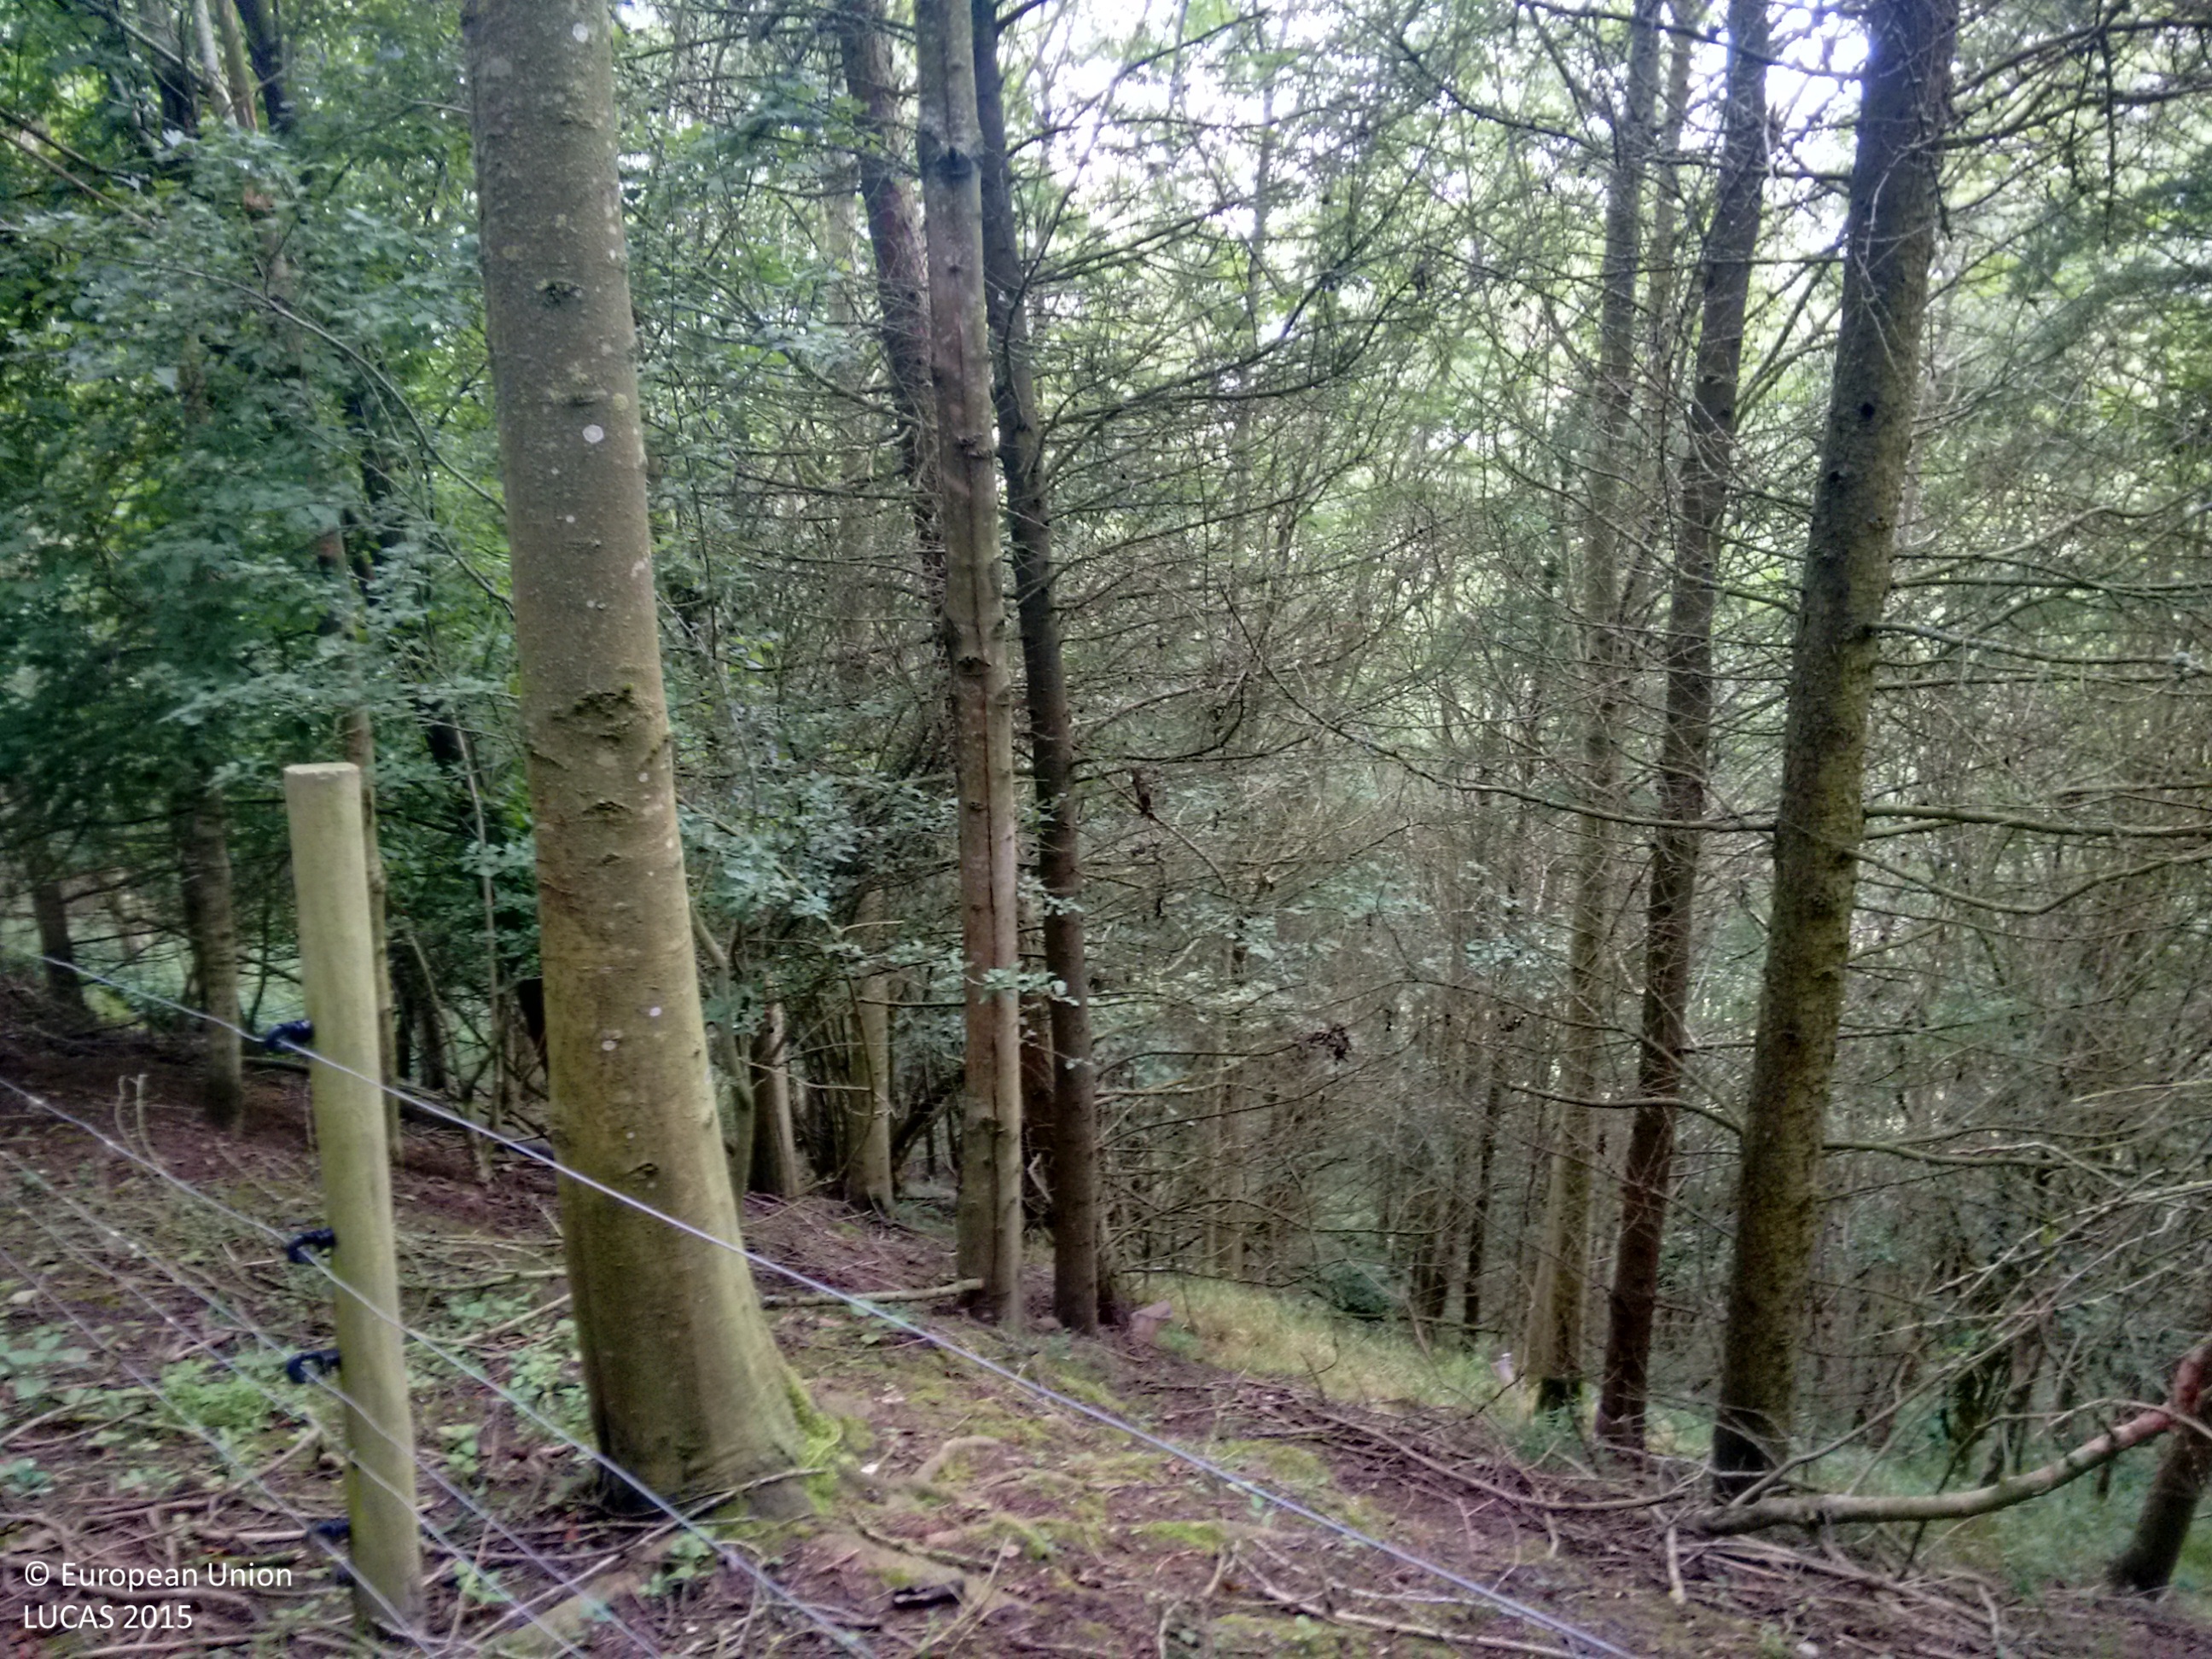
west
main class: Woodland
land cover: Other mixed woodland
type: mesophytic deciduous forest
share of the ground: > 75 %
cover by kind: broadleaved forest trees 55 %, coniferous forest trees 40 %, shrubs 5 %
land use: Semi-natural and natural areas not in use
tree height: > 5 m
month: July
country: GB
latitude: 52.3836
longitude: -2.8694
